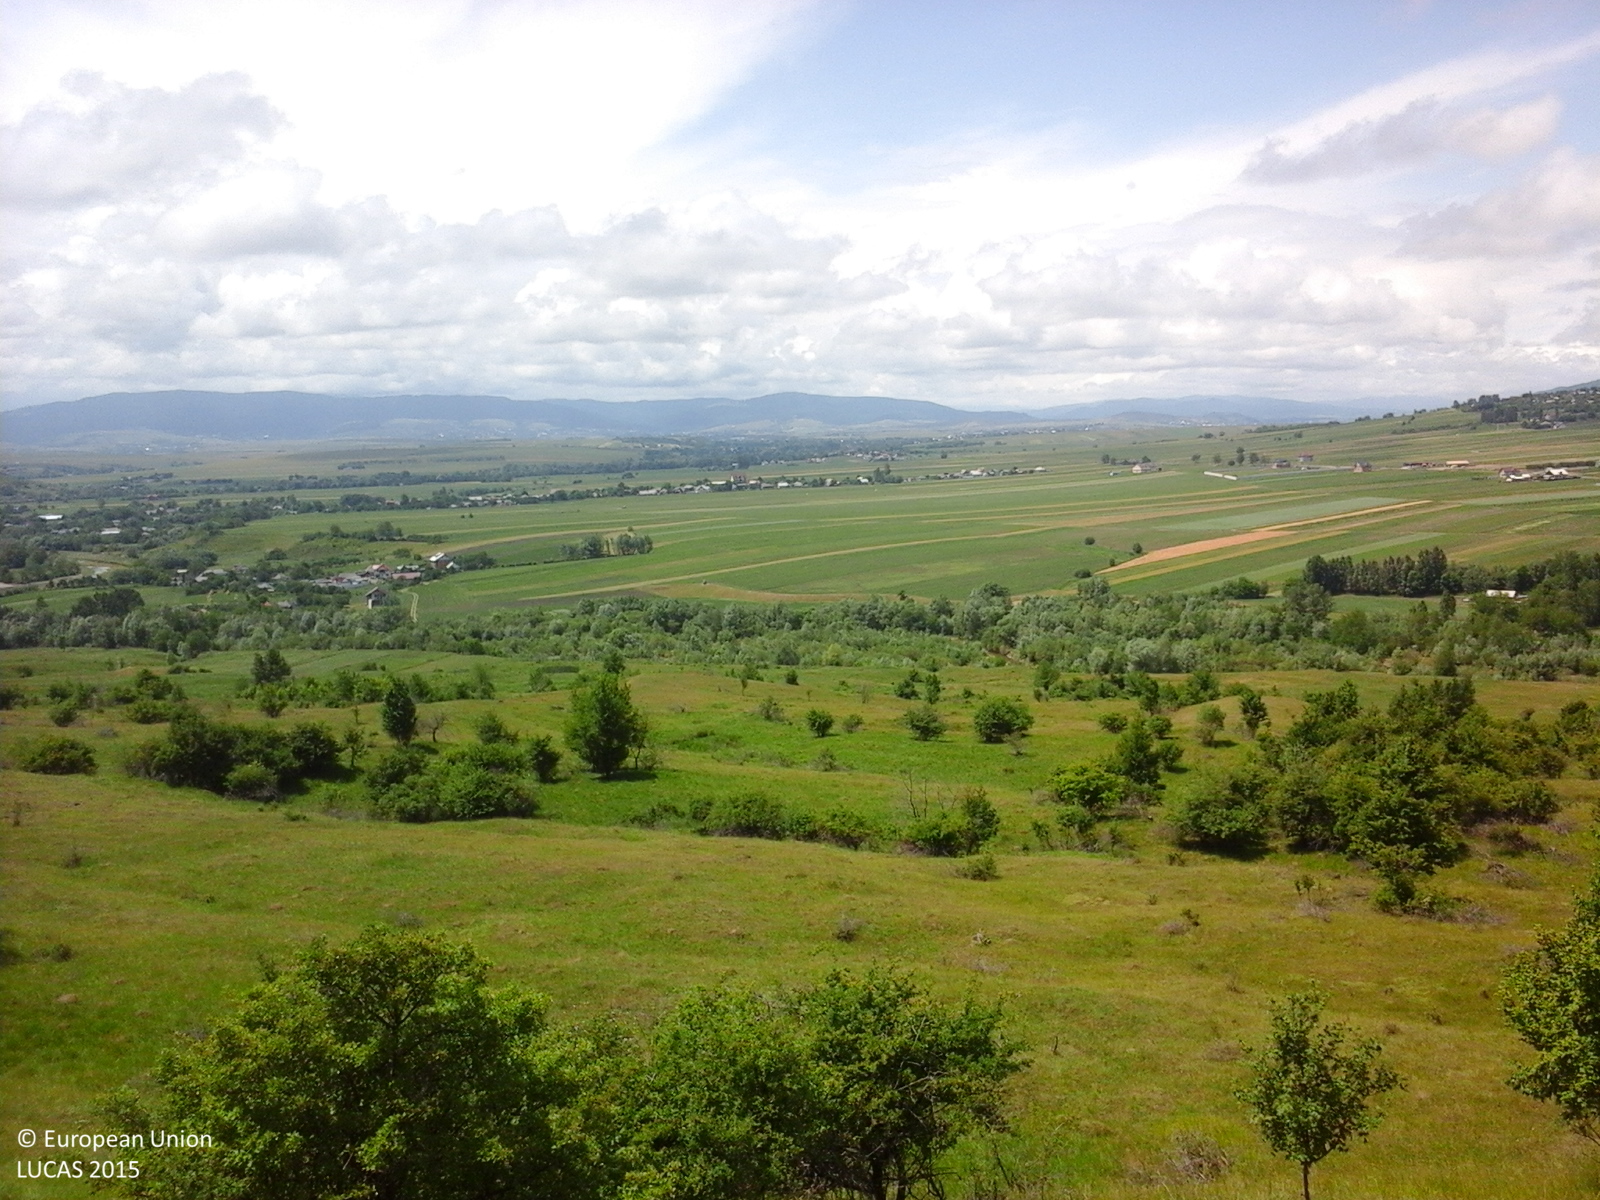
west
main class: Grassland
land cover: Grassland with sparse tree/shrub cover
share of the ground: > 75 %
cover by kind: herbaceous plants 85 %, shrubs 10 %, broadleaved forest trees 5 %
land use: Agriculture (excluding fallow land and kitchen gardens)
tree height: > 5 m
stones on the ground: < 10 %
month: June
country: RO
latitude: 47.1594
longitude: 26.4546
